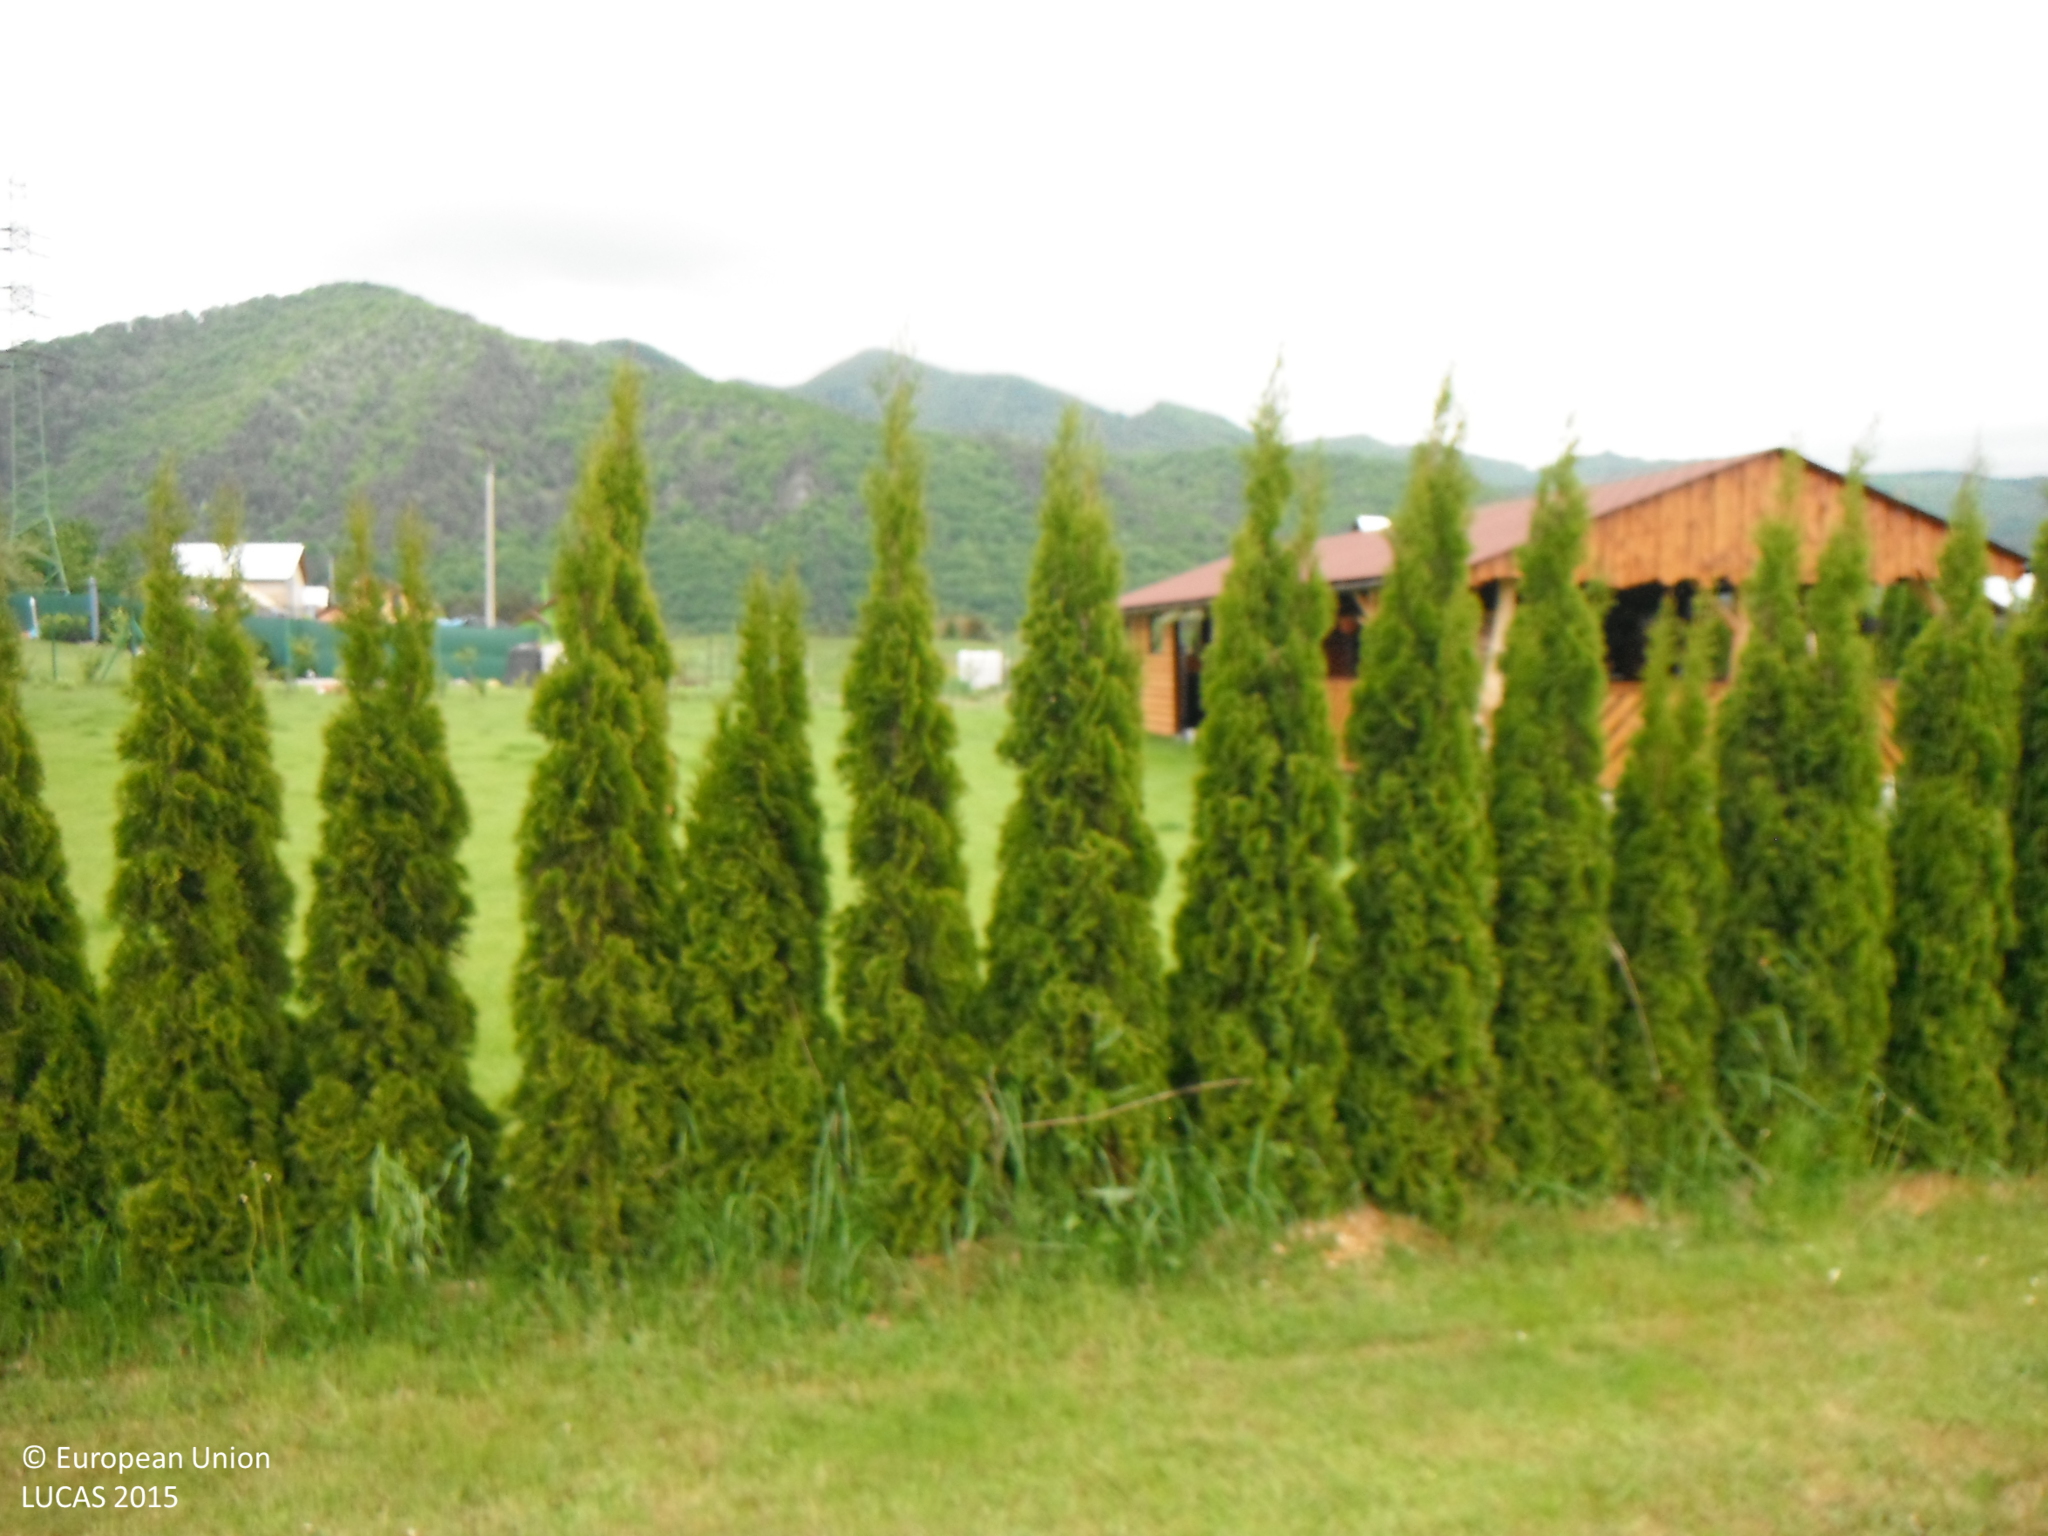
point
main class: Grassland
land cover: Grassland without tree/shrub cover
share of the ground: > 75 %
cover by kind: herbaceous plants 100 %
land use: Residential
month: May
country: SK
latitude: 49.1334
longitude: 19.0819
